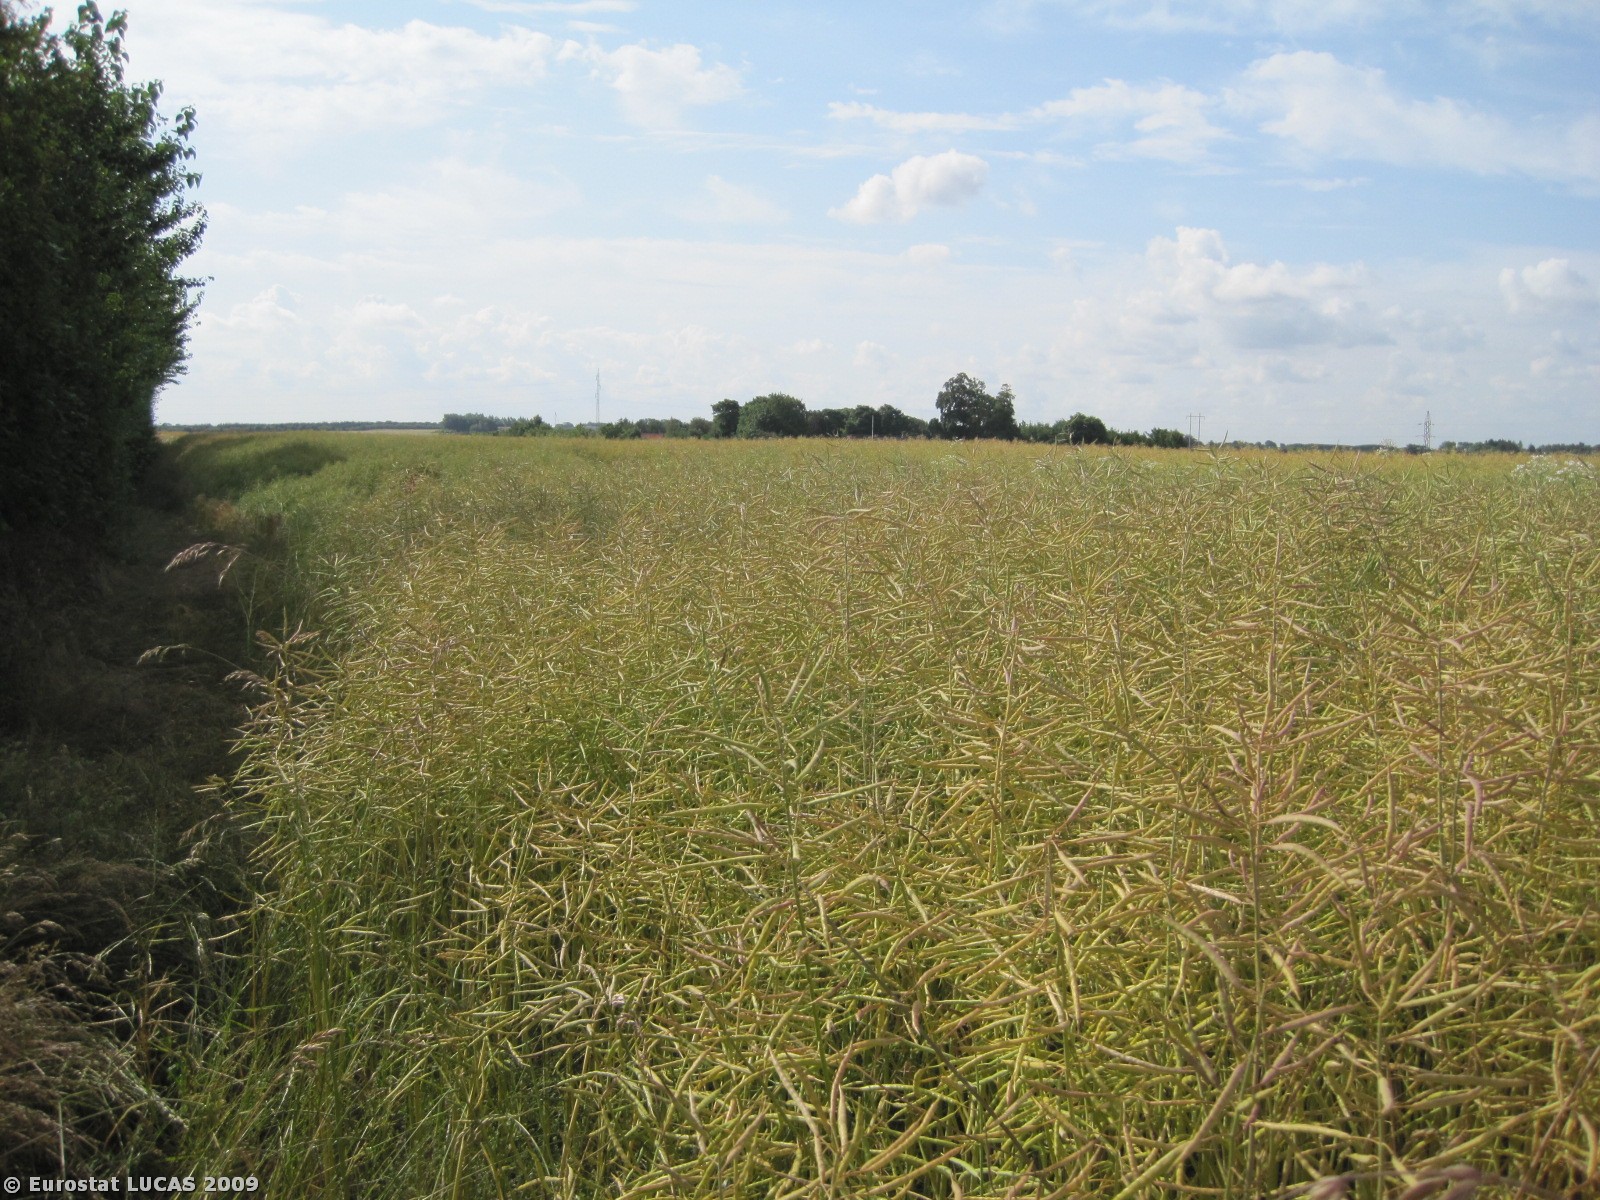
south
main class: Cropland
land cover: Rape and turnip rape
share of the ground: > 75 %
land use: Agriculture (excluding fallow land and kitchen gardens)
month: July
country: DK
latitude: 56.6190
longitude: 9.7884
